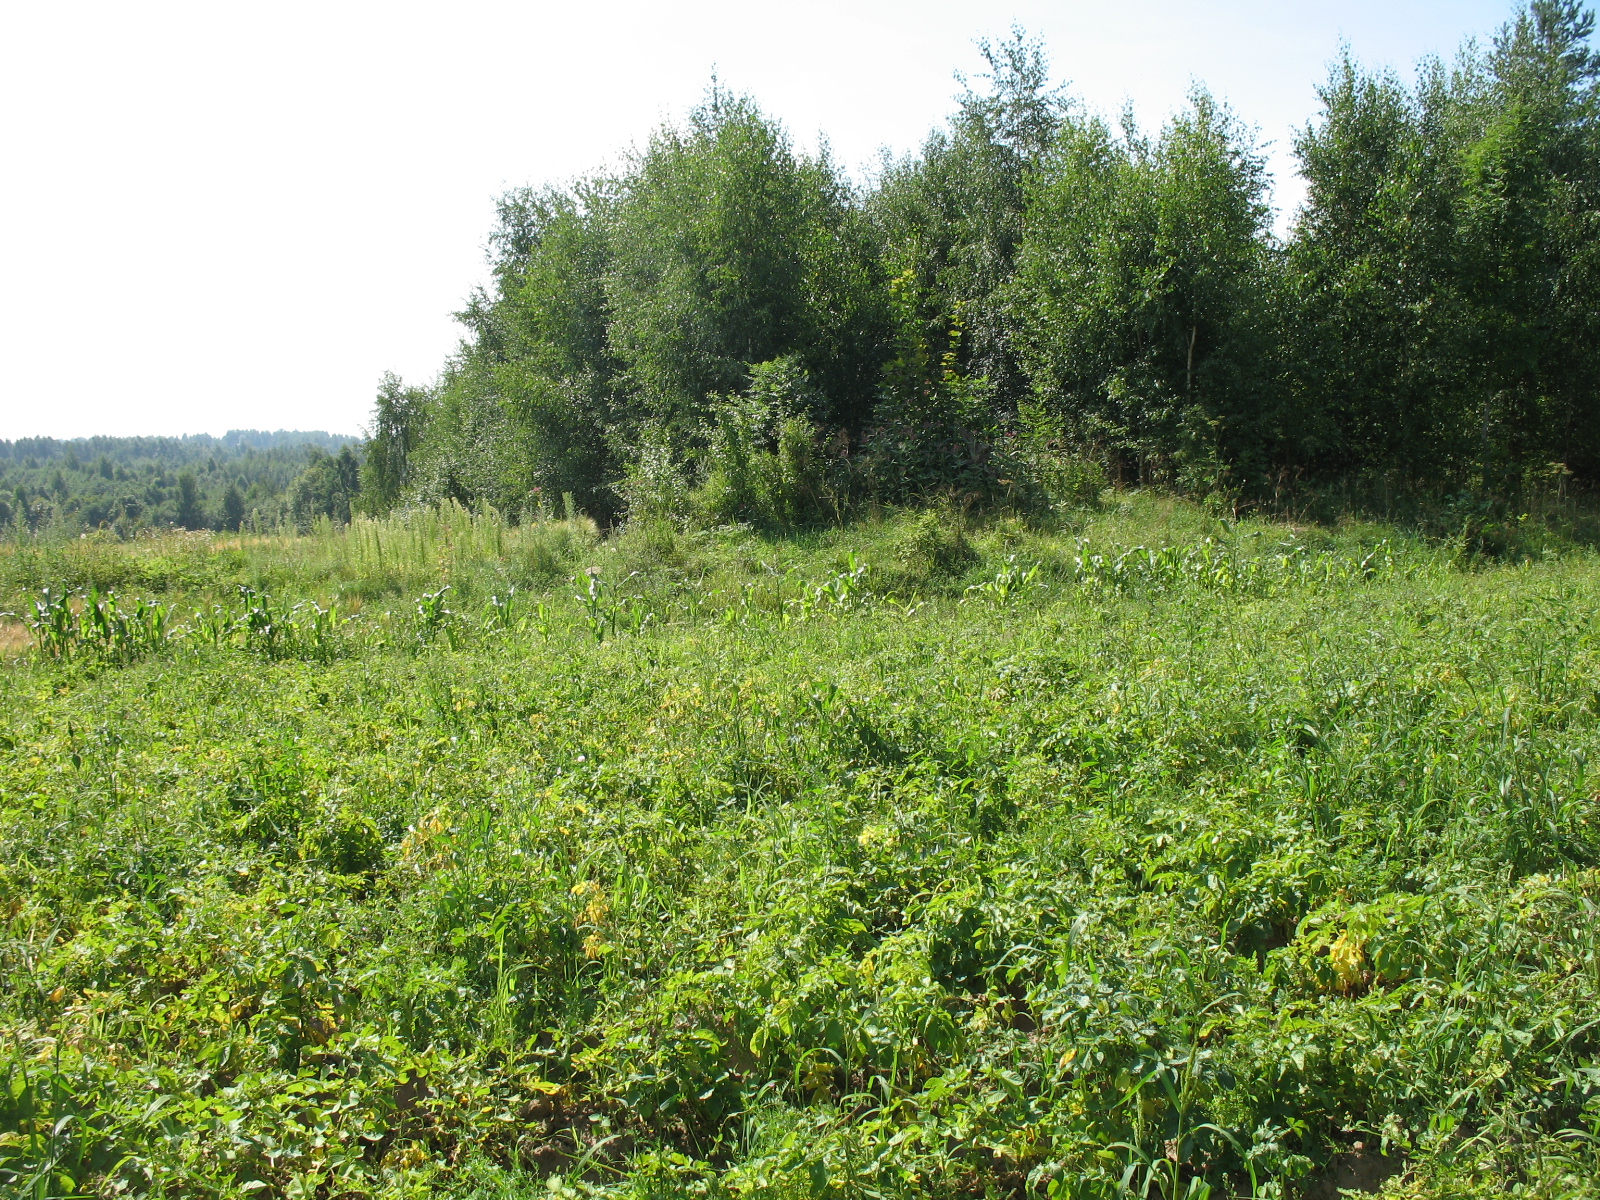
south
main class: Cropland
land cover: Barley
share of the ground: > 75 %
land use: Agriculture (excluding fallow land and kitchen gardens)
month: August
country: LV
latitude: 56.4080
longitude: 25.5334
